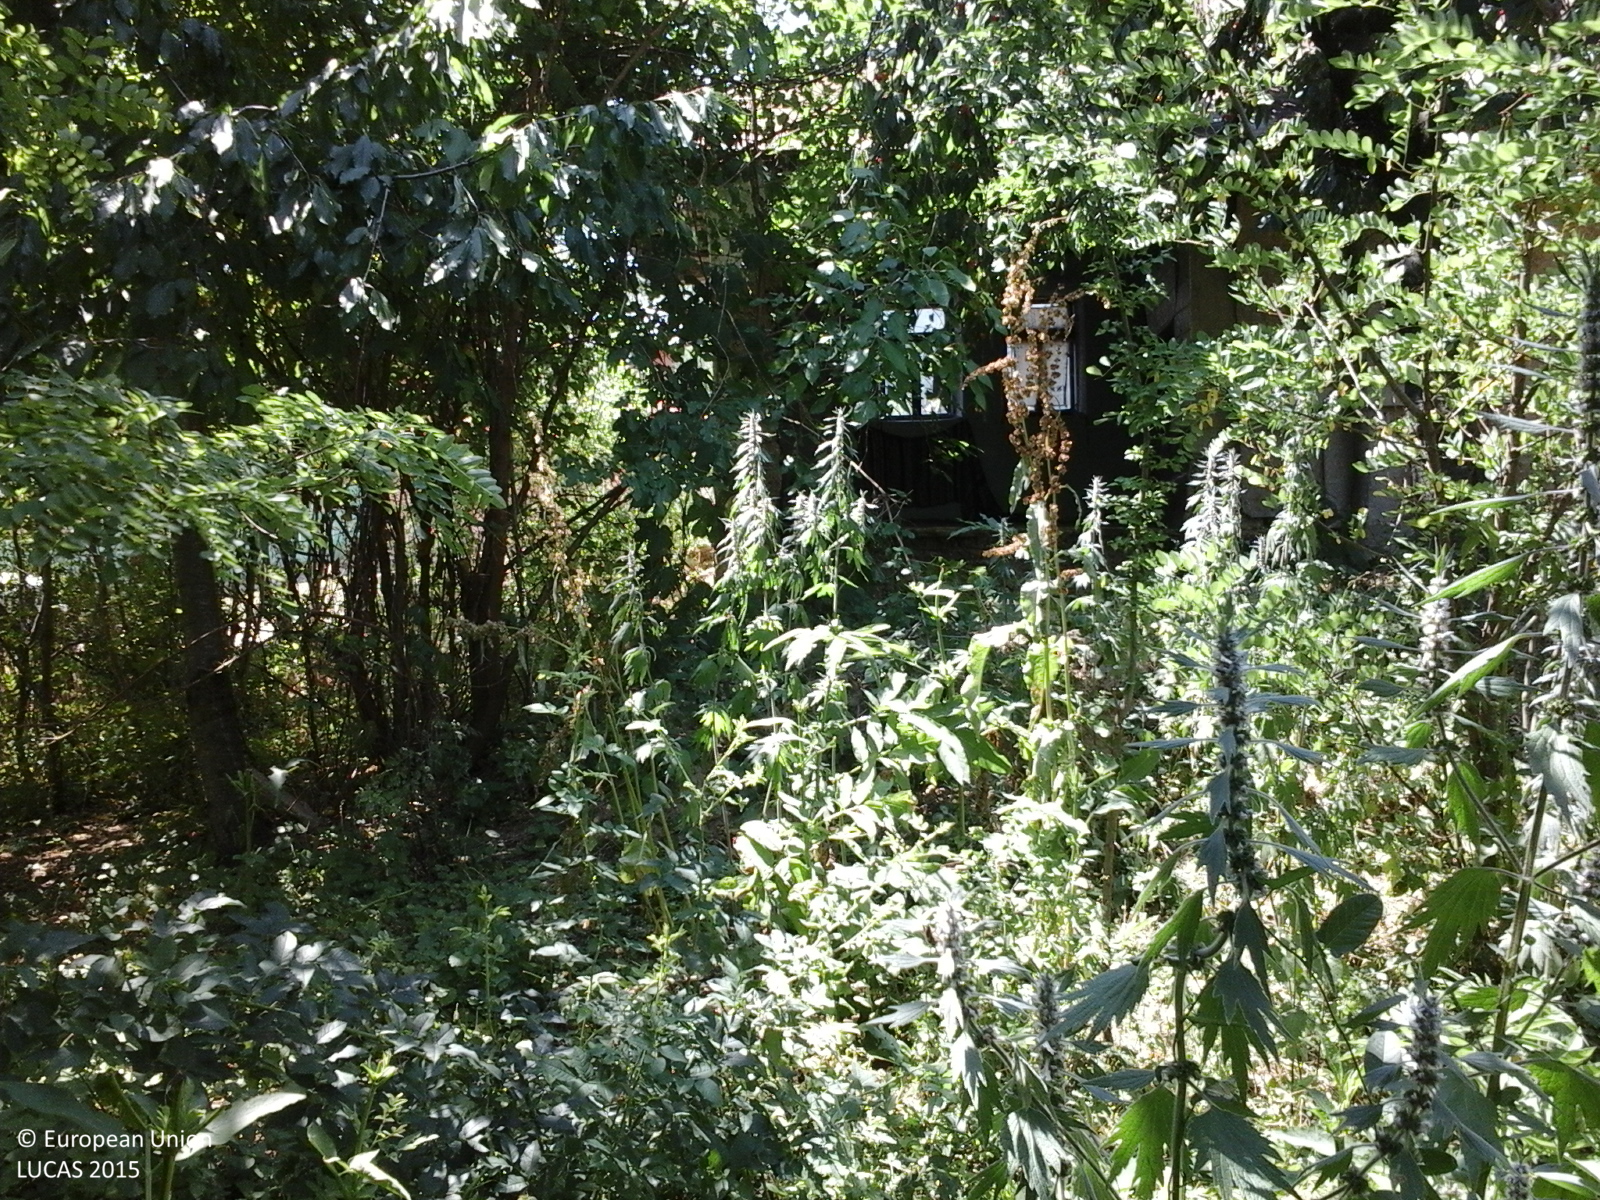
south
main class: Woodland
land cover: Broadleaved woodland
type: beech forest
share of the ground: > 75 %
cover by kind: broadleaved forest trees 100 %
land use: Forestry
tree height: > 5 m
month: June
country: RO
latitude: 46.8141
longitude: 28.0191
